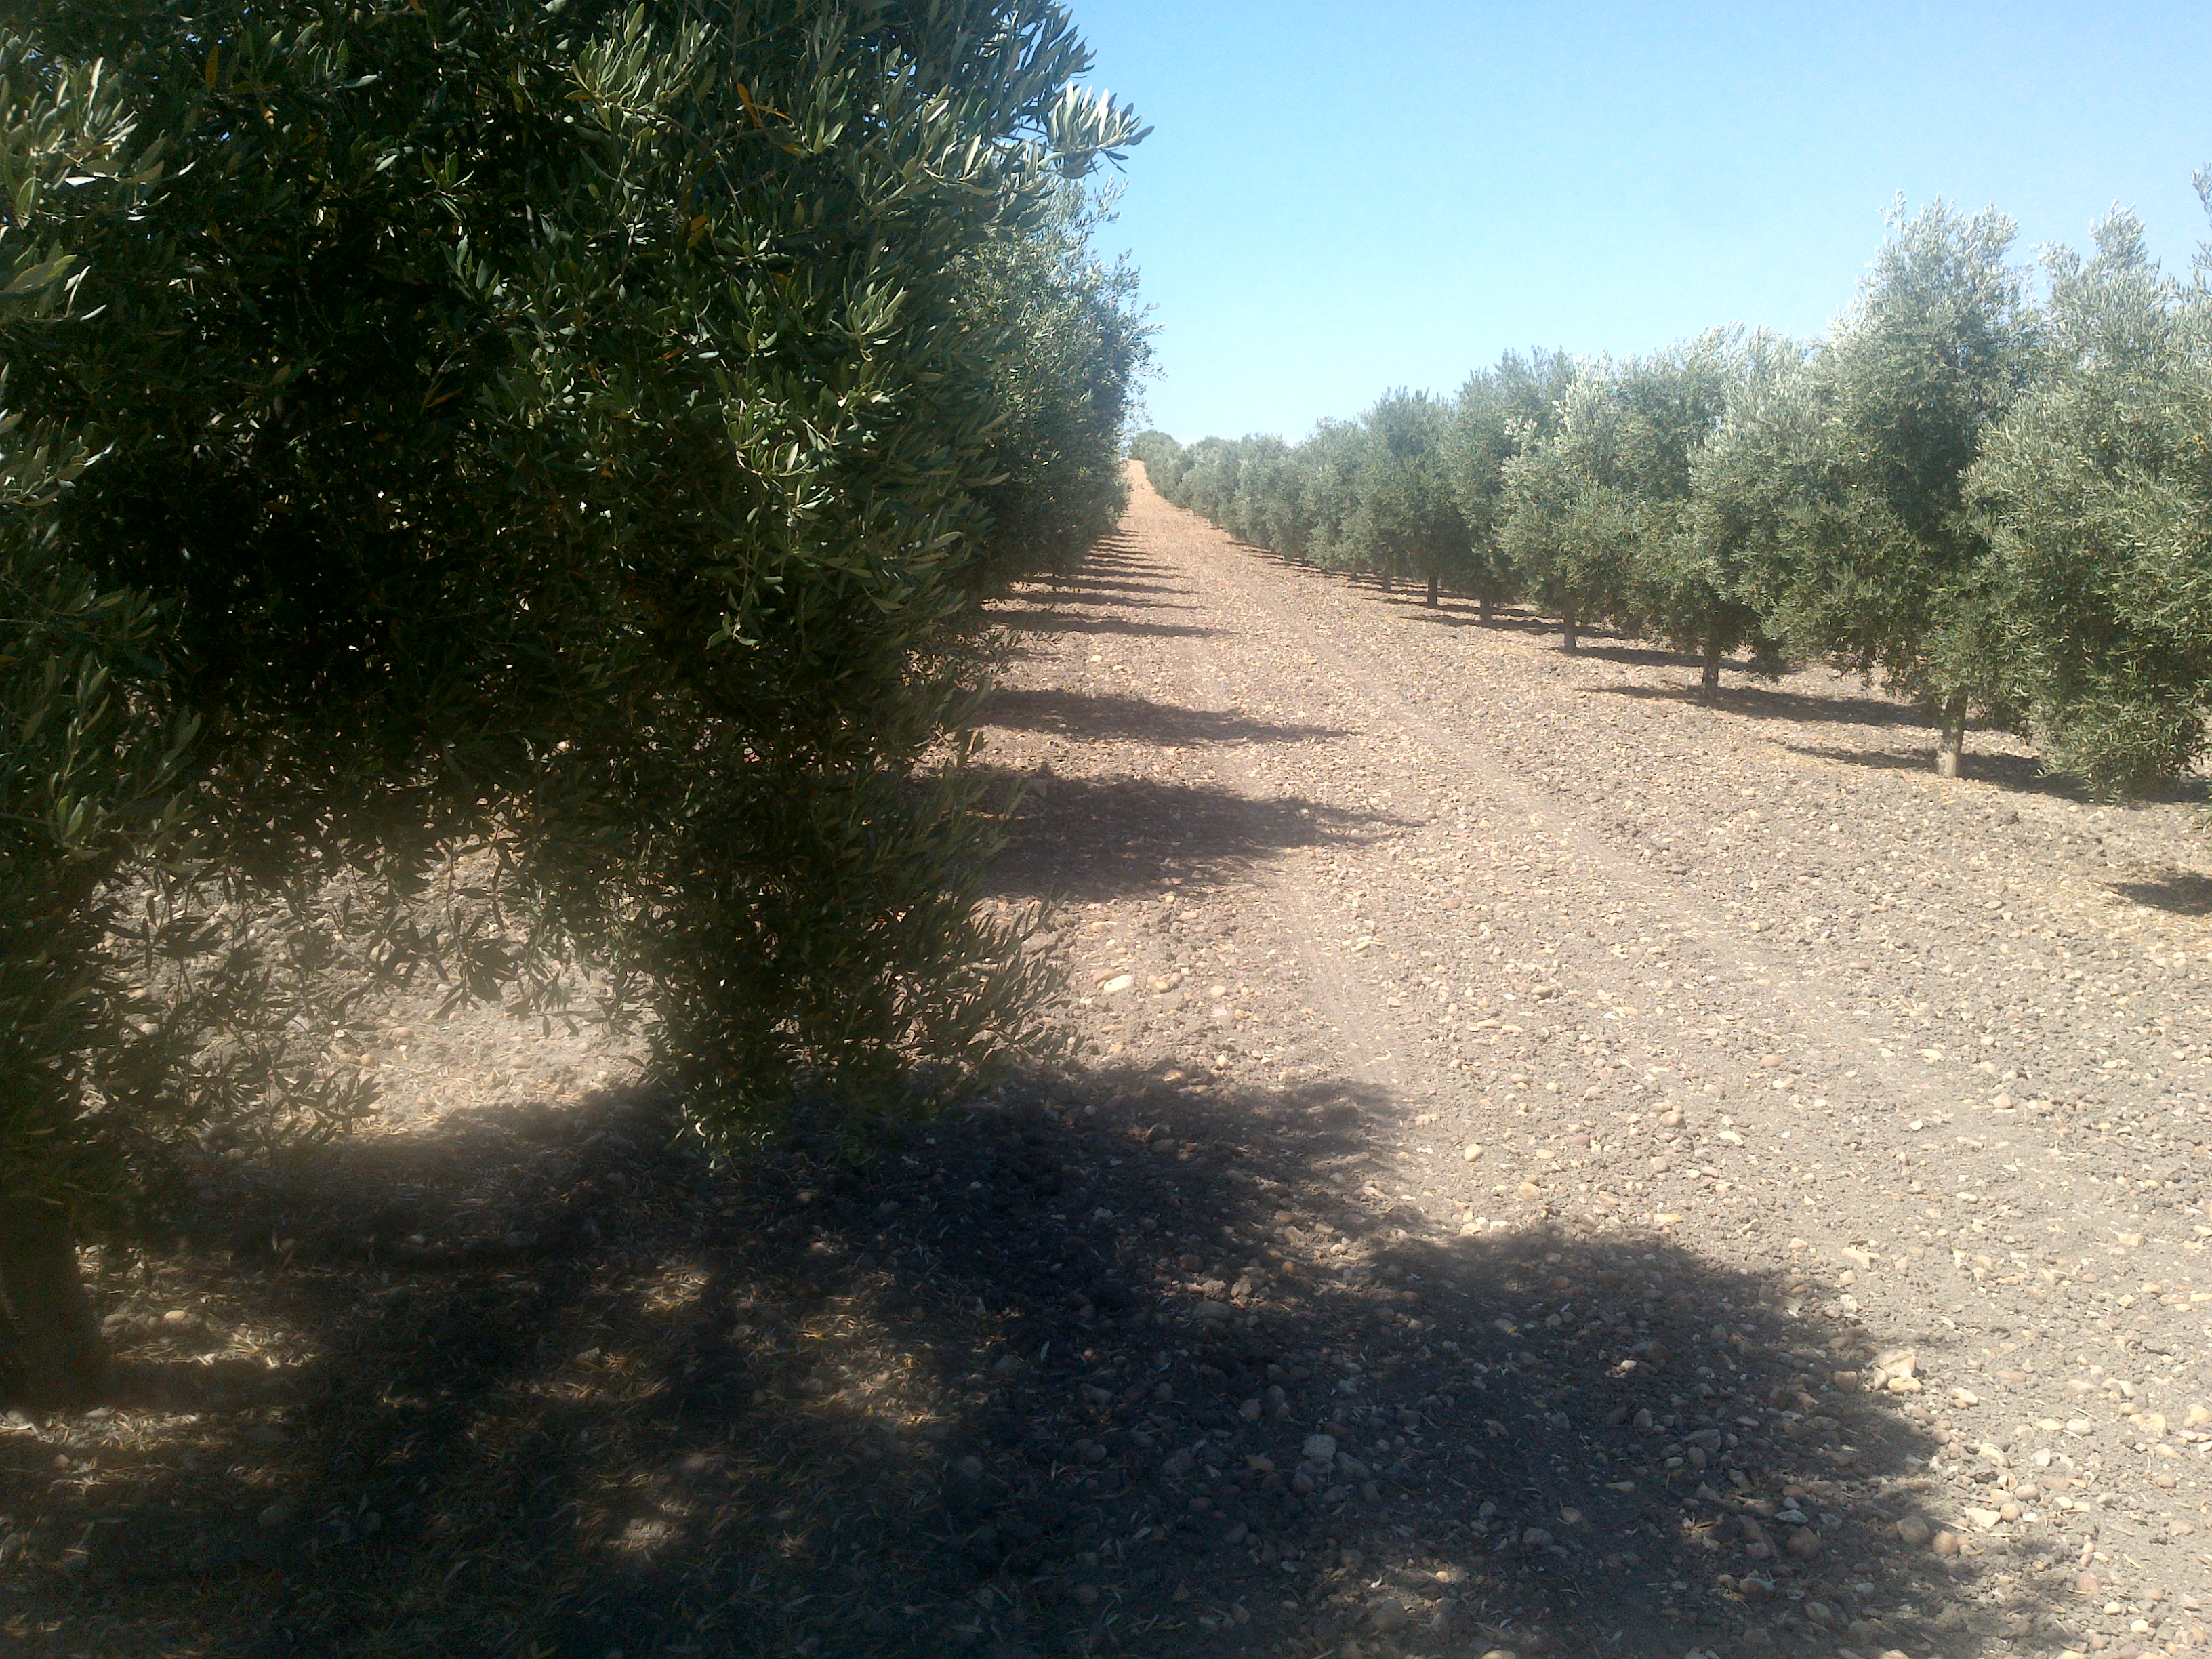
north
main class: Cropland
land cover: Olive groves
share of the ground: 50 - 75 %
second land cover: Other bare soil
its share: > 75 %
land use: Agriculture (excluding fallow land and kitchen gardens)
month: June
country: ES
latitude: 37.5997
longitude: -4.8828
